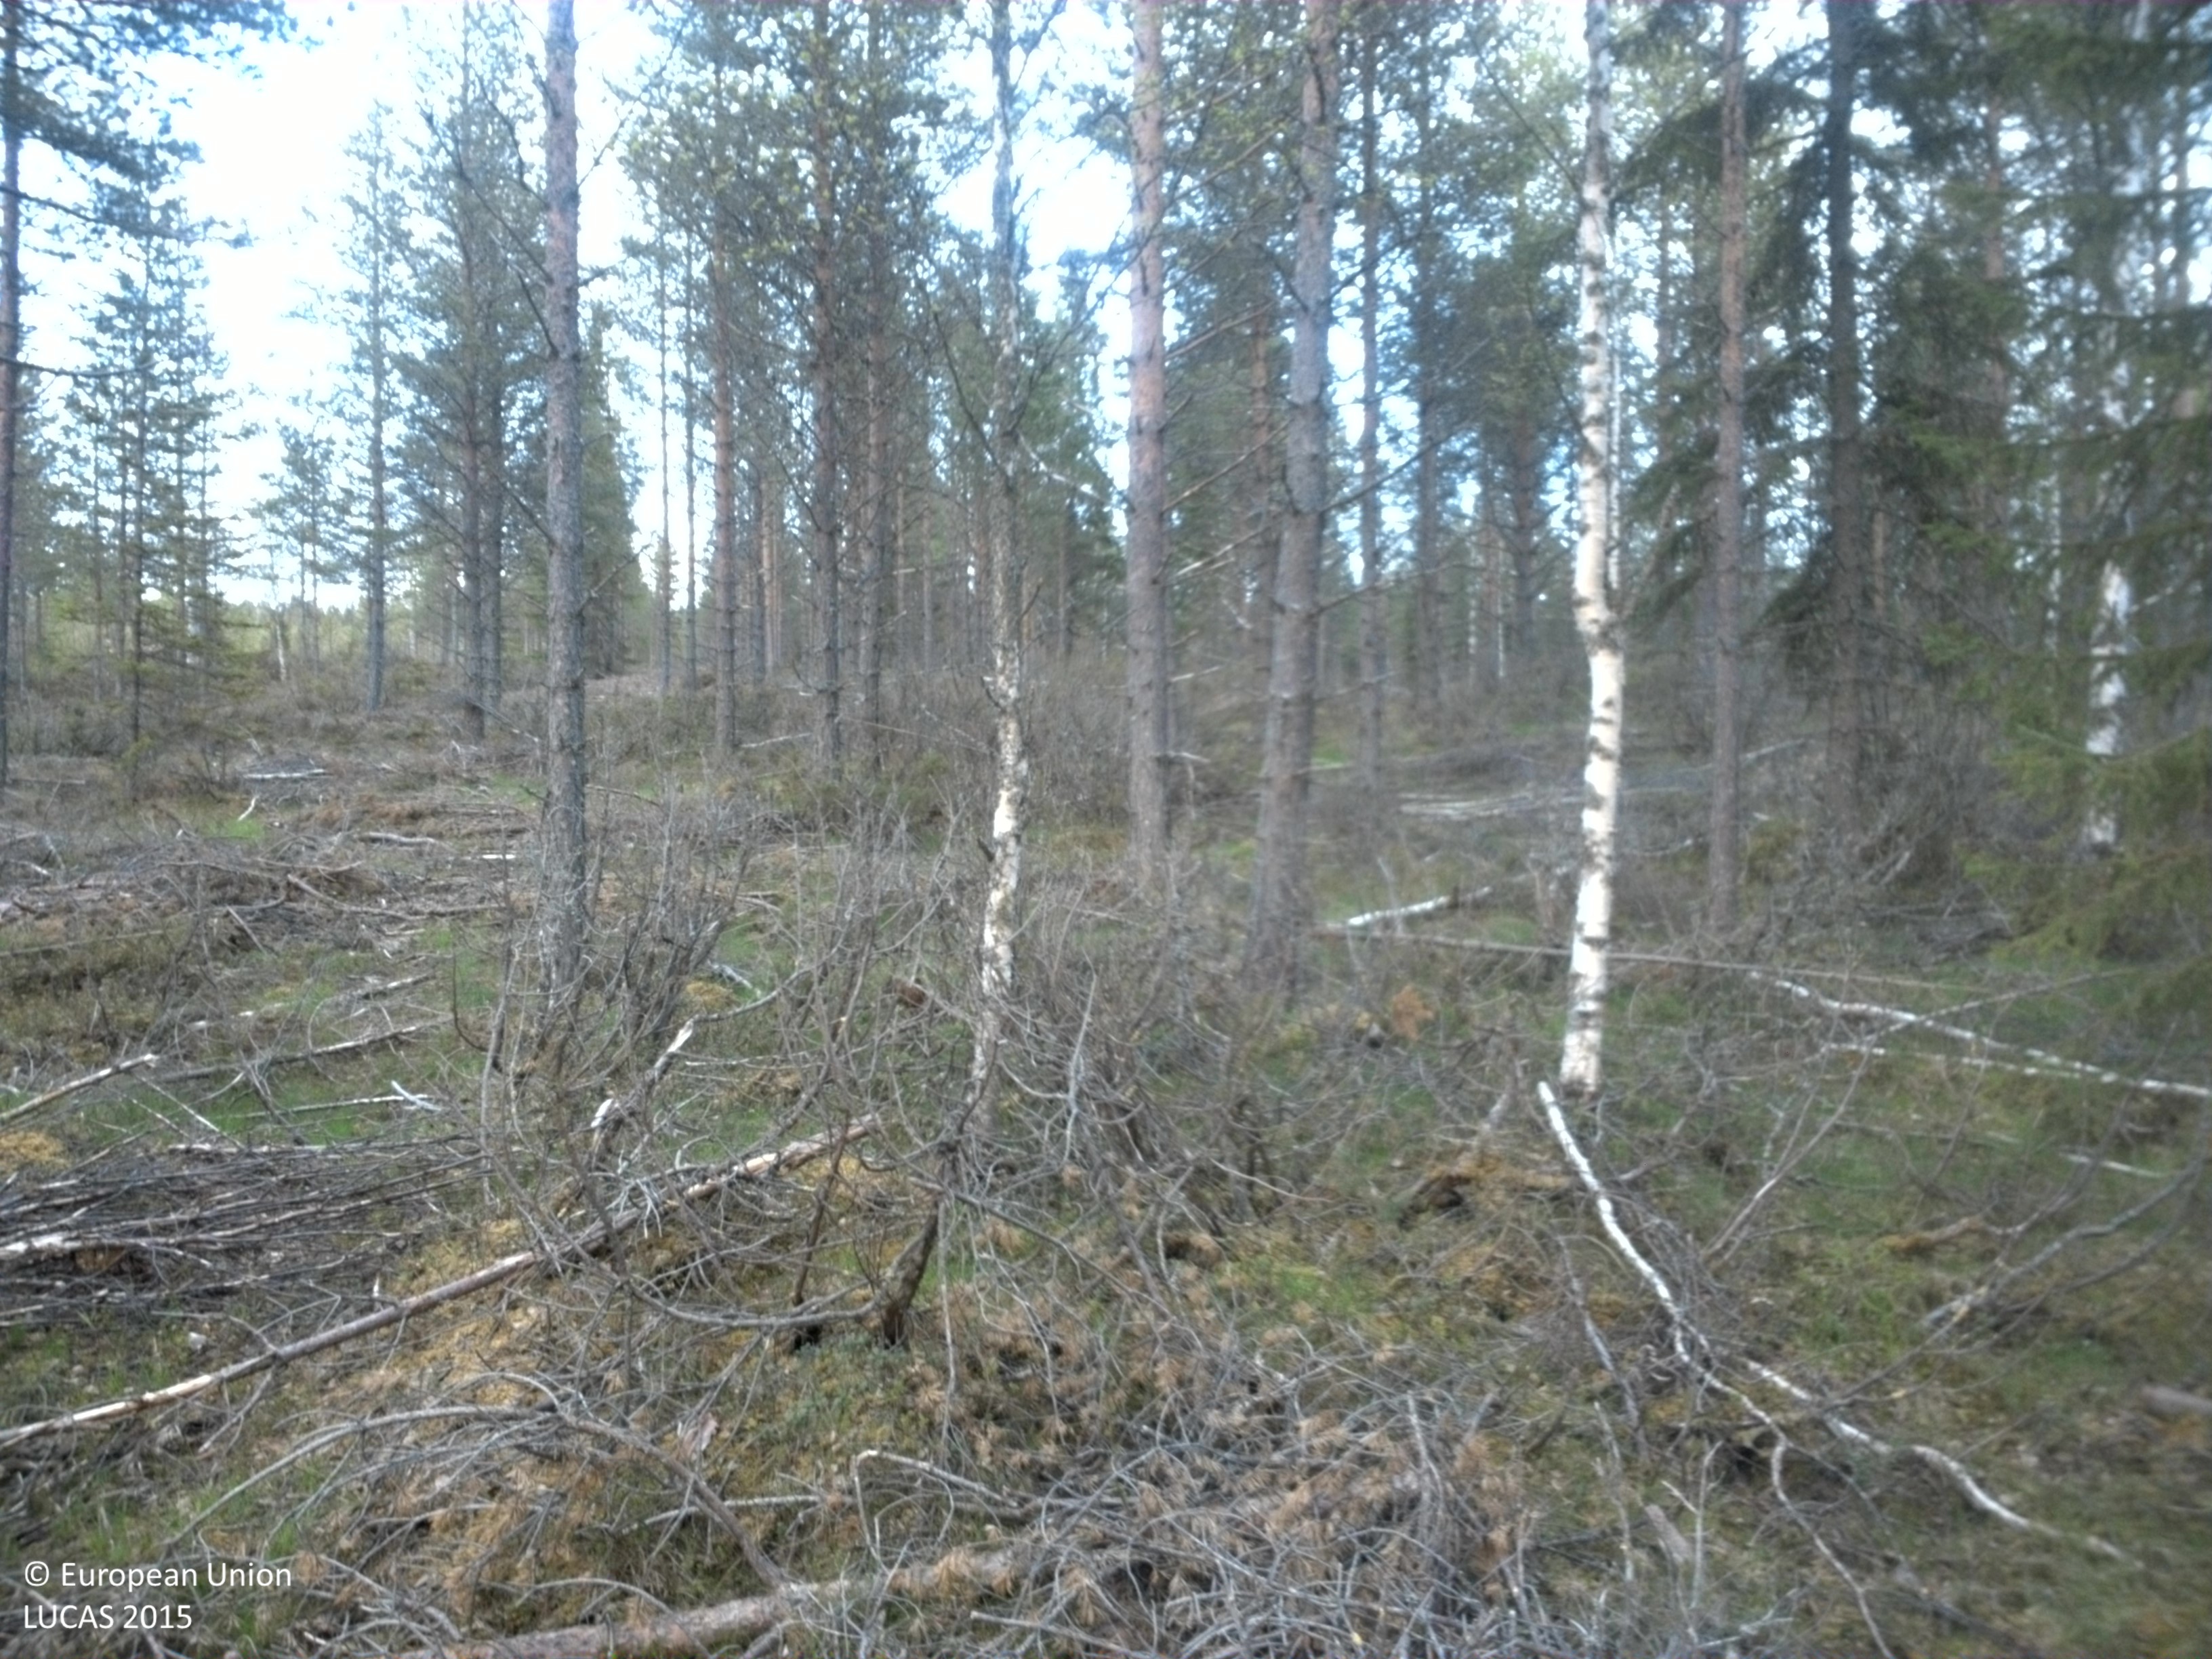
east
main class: Woodland
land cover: Pine dominated mixed woodland
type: boreal forest
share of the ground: 50 - 75 %
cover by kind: coniferous forest trees 45 %, shrubs 30 %, broadleaved forest trees 15 %, lichens and mosses 10 %
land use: Forestry
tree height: > 5 m
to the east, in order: Pine dominated mixed woodland; Pine dominated coniferous woodland
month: June
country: SE
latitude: 61.0782
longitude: 13.3438
